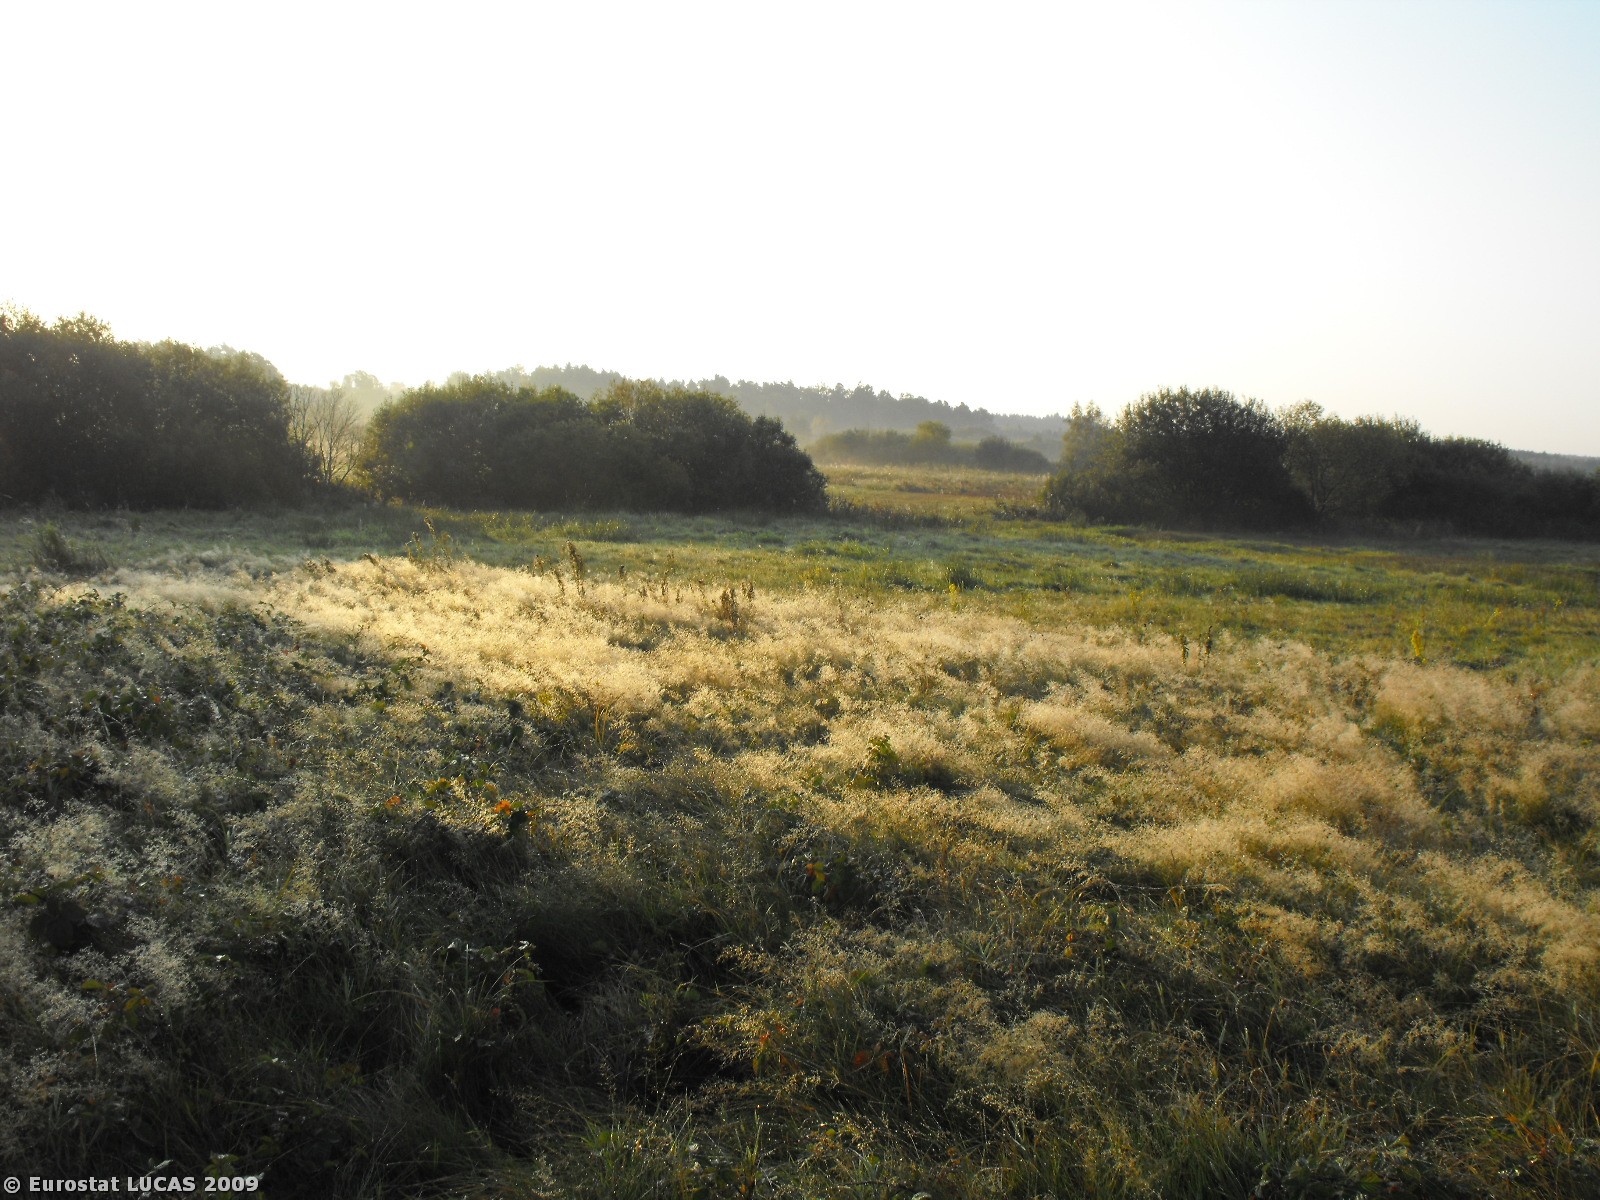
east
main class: Grassland
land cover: Grassland with sparse tree/shrub cover
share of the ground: > 75 %
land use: Nature reserves
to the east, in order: Grassland with sparse tree/shrub cover; Abandoned hedges; Grassland without tree/shrub cover; Abandoned hedges
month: September
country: PL
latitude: 54.4227
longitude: 16.7420
